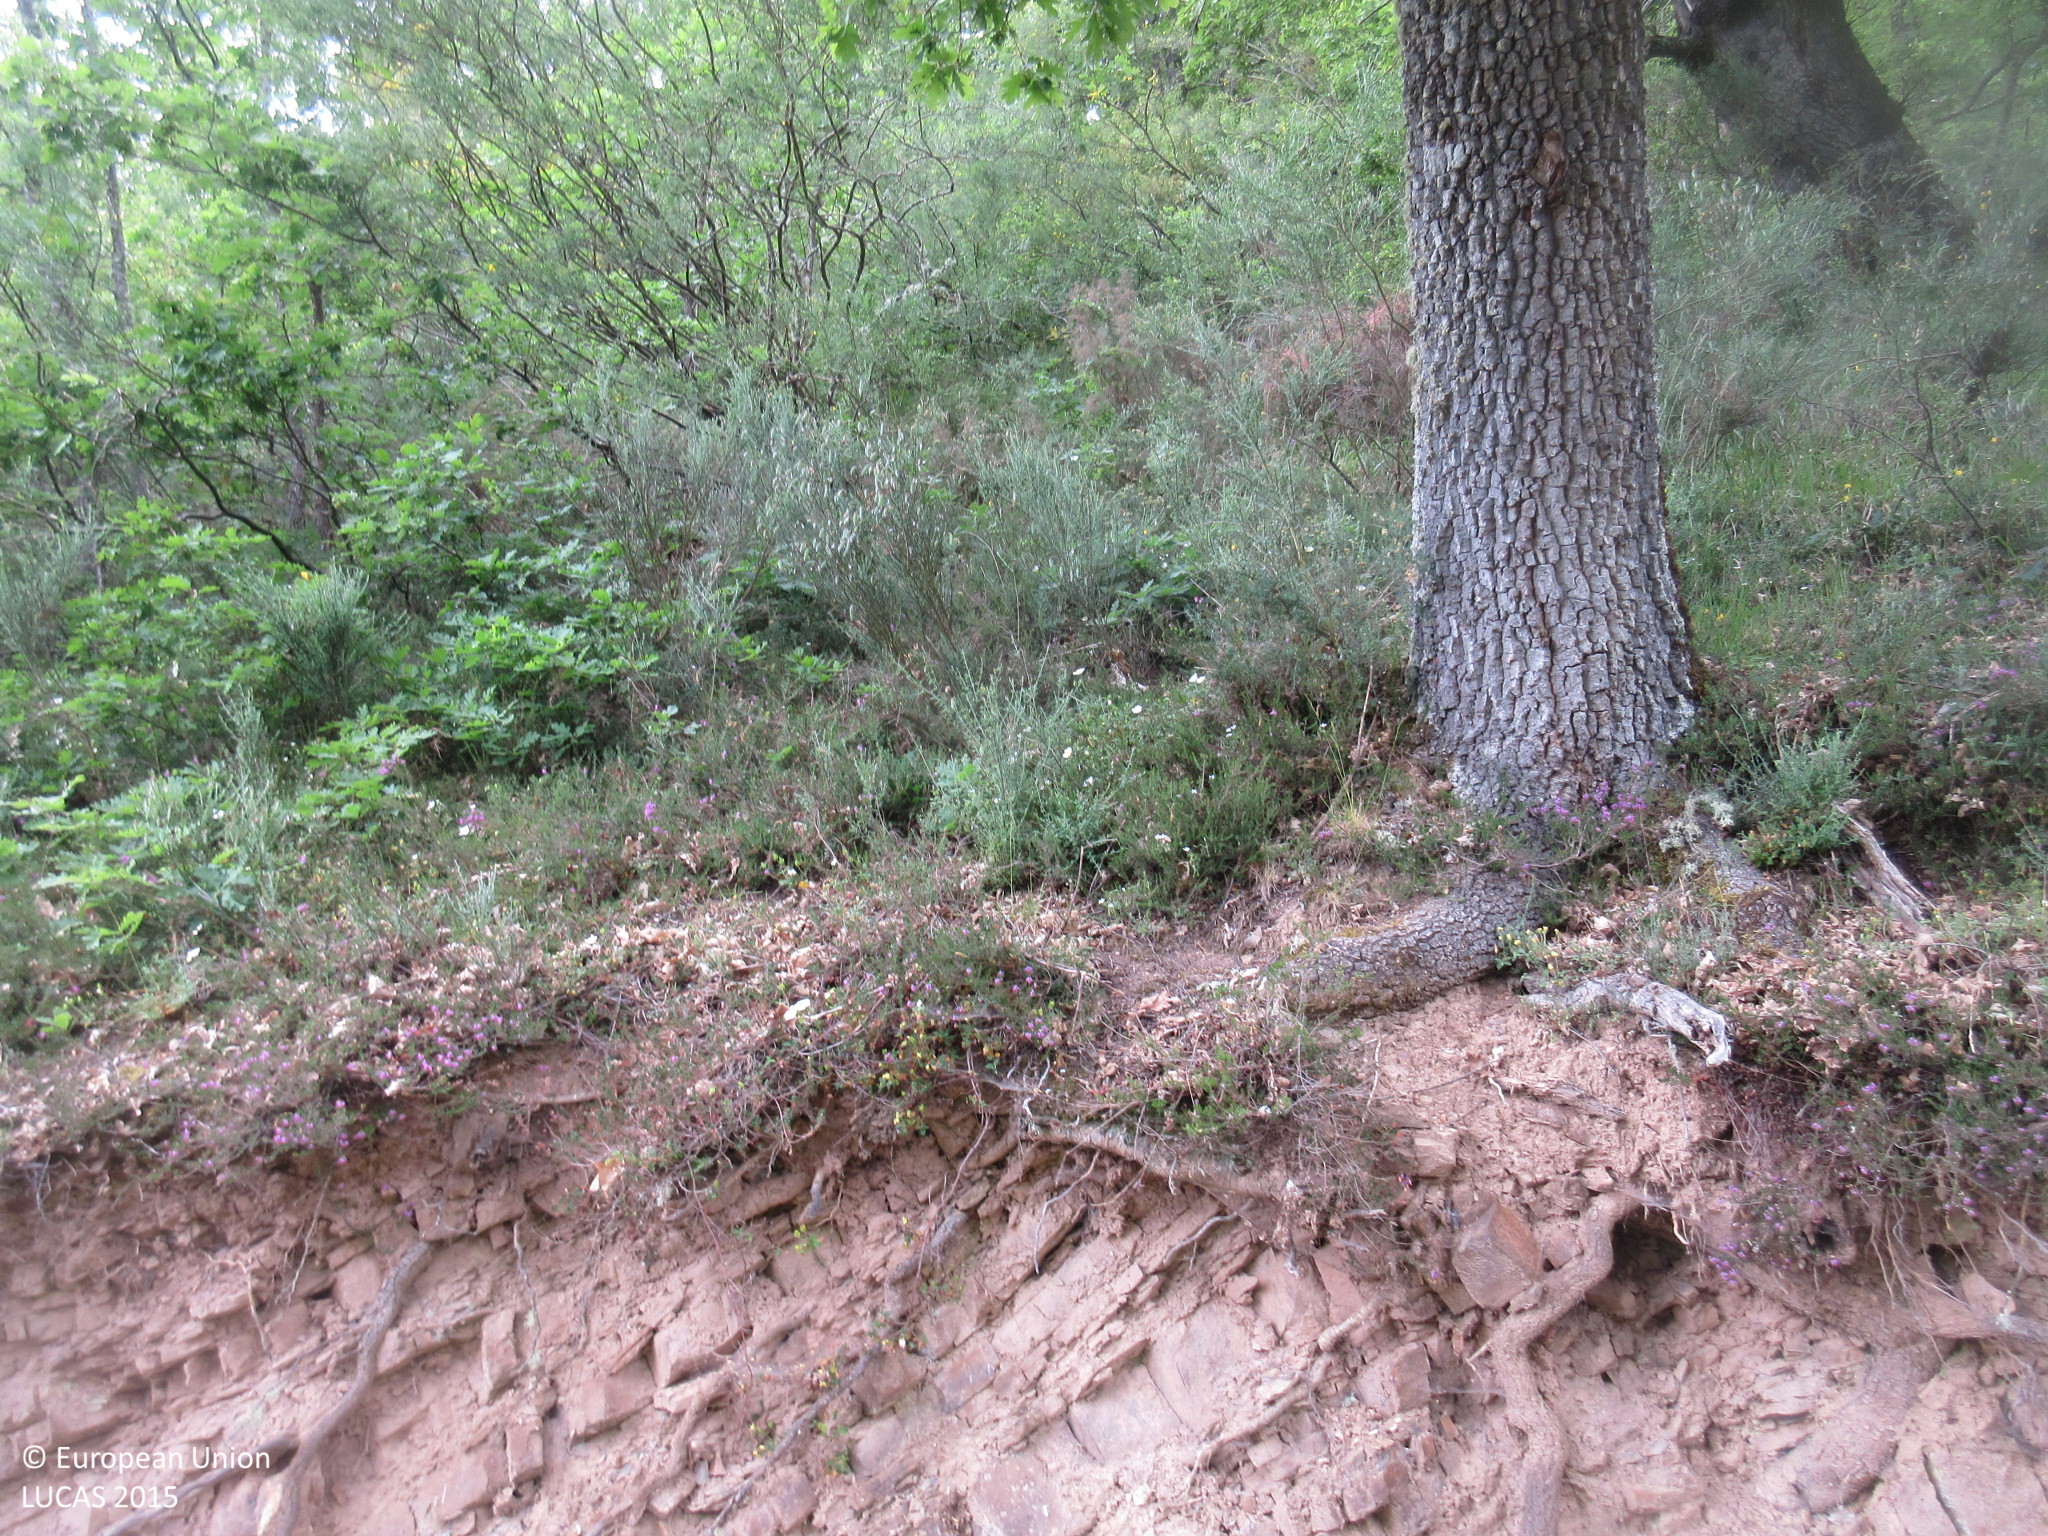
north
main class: Woodland
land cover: Broadleaved woodland
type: thermophilous deciduous forest
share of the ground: > 75 %
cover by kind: broadleaved forest trees 95 %, unconsolidated bare surface 5 %
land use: Semi-natural and natural areas not in use
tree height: > 5 m
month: June
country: ES
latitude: 43.1385
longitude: -4.5289
